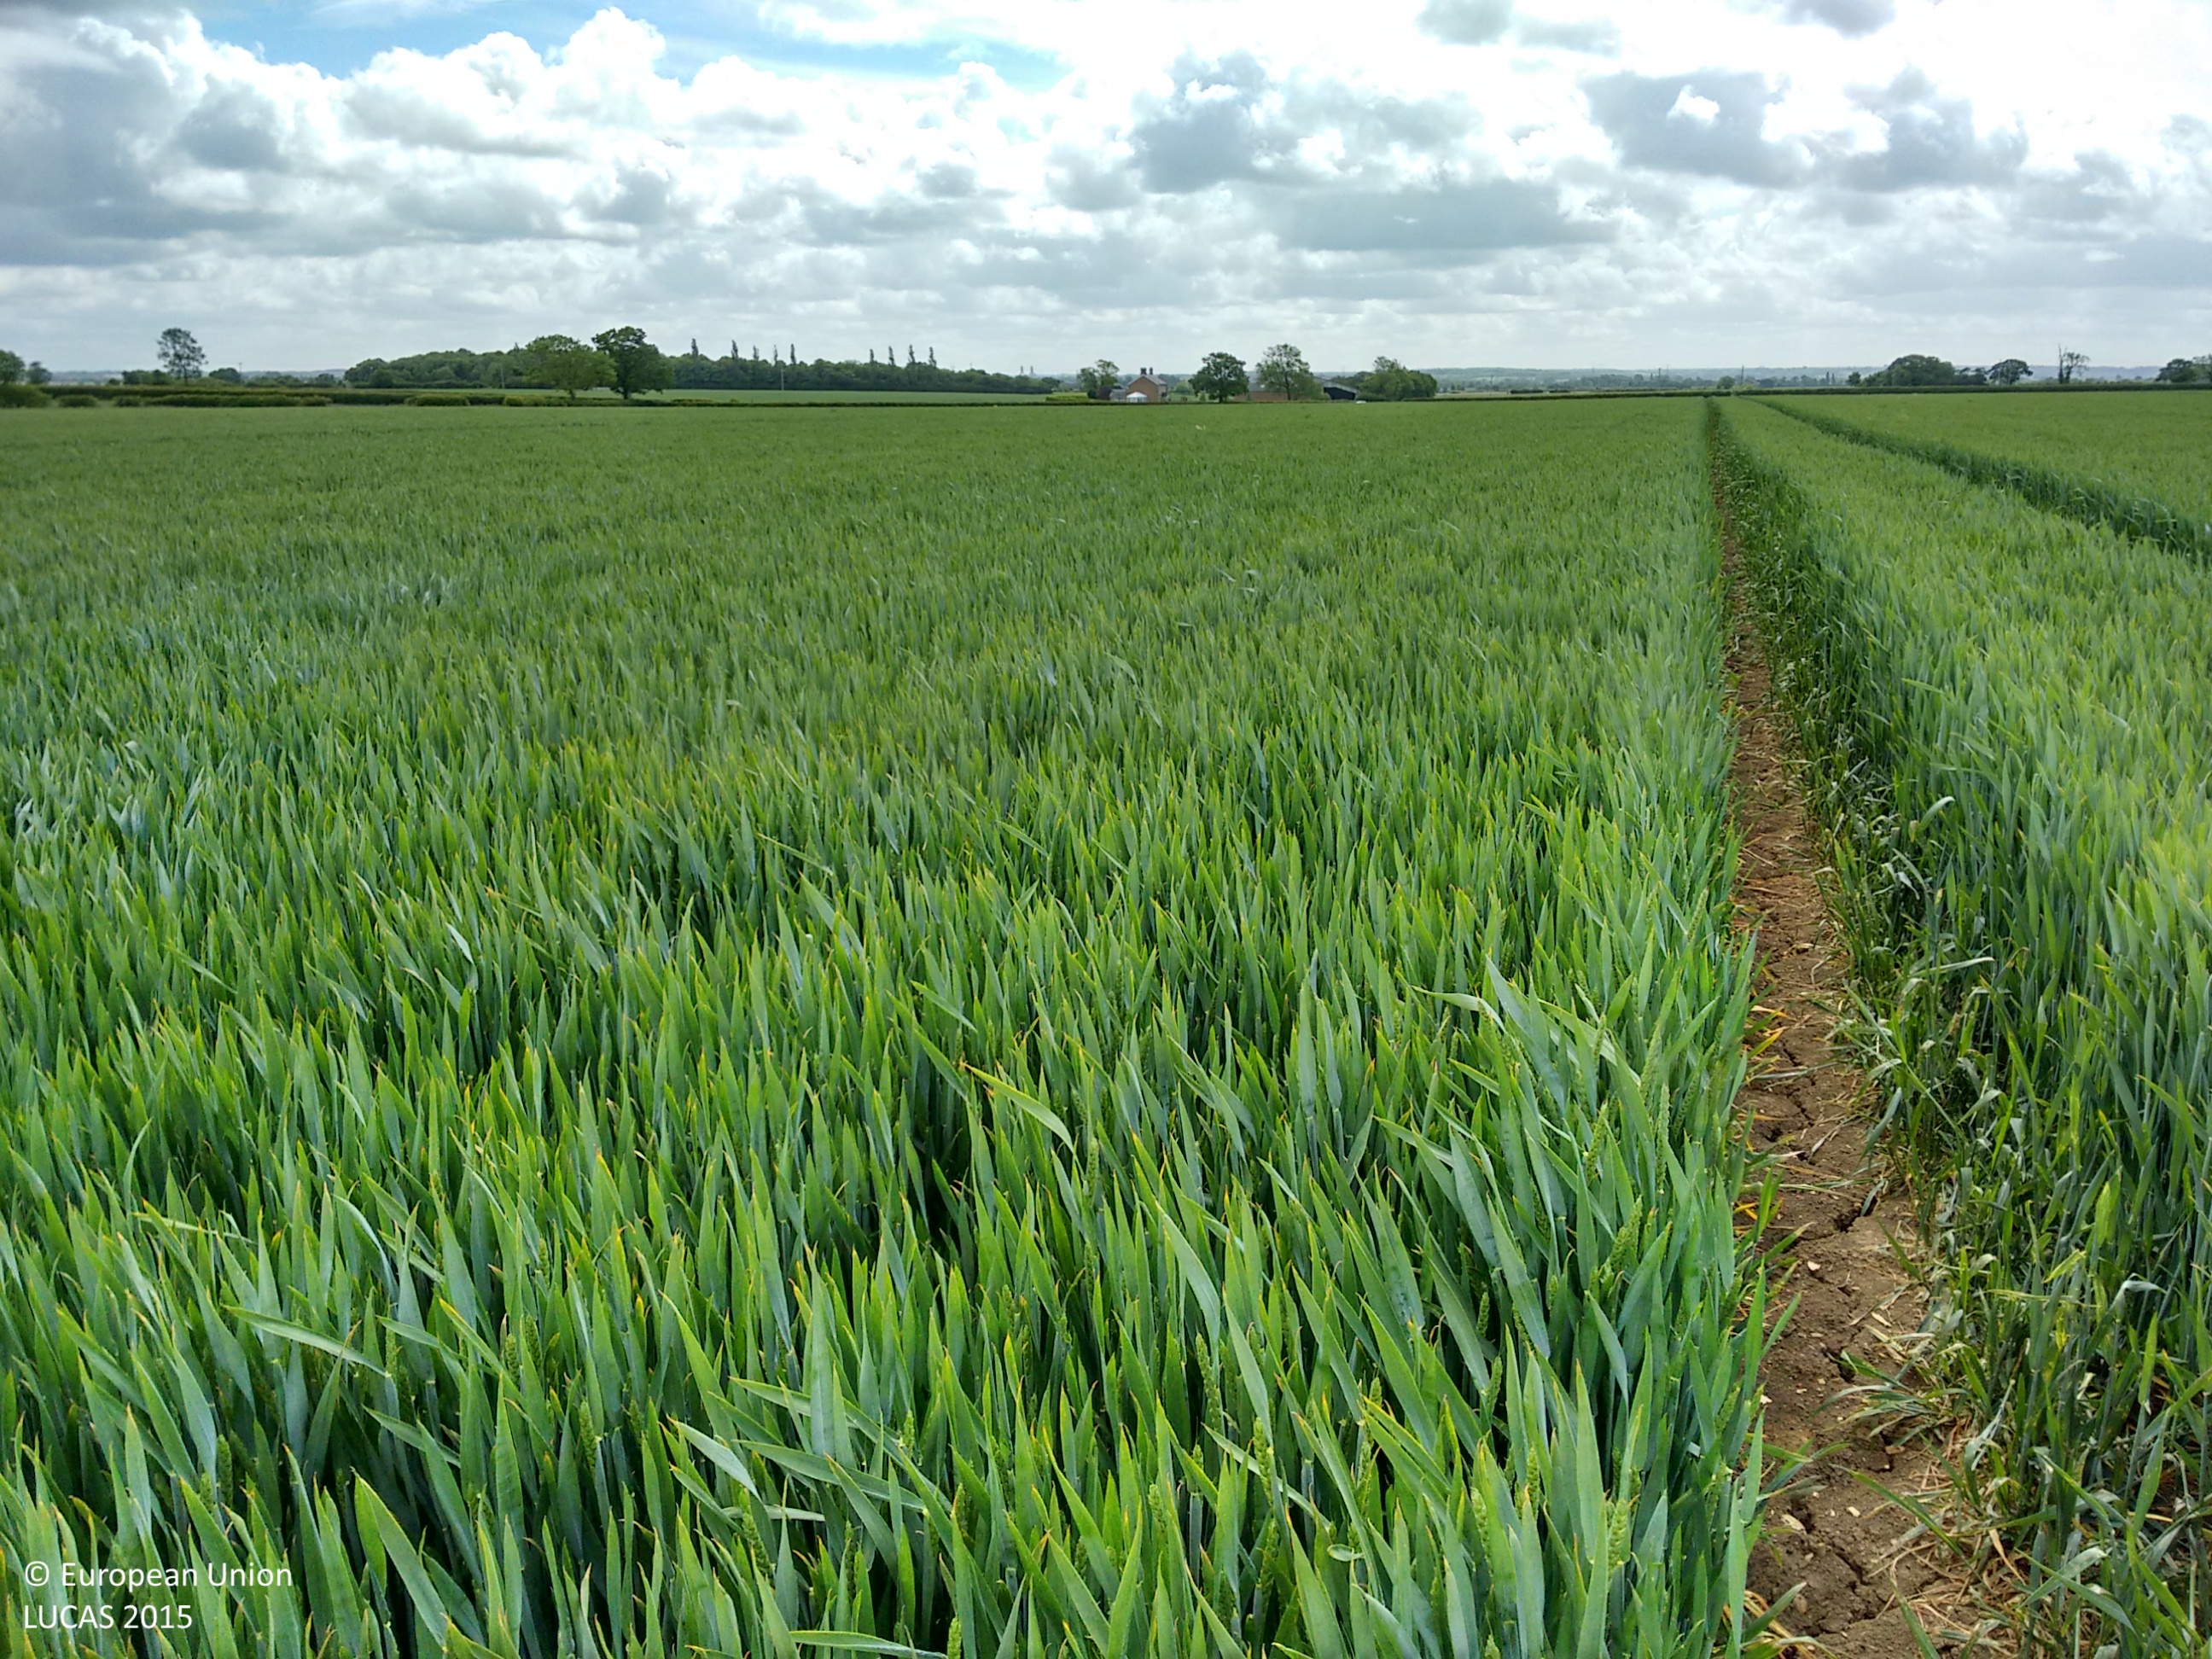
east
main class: Cropland
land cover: Common wheat
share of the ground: > 75 %
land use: Agriculture (excluding fallow land and kitchen gardens)
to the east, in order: Common wheat
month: June
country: GB
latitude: 52.2135
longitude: -0.3547
